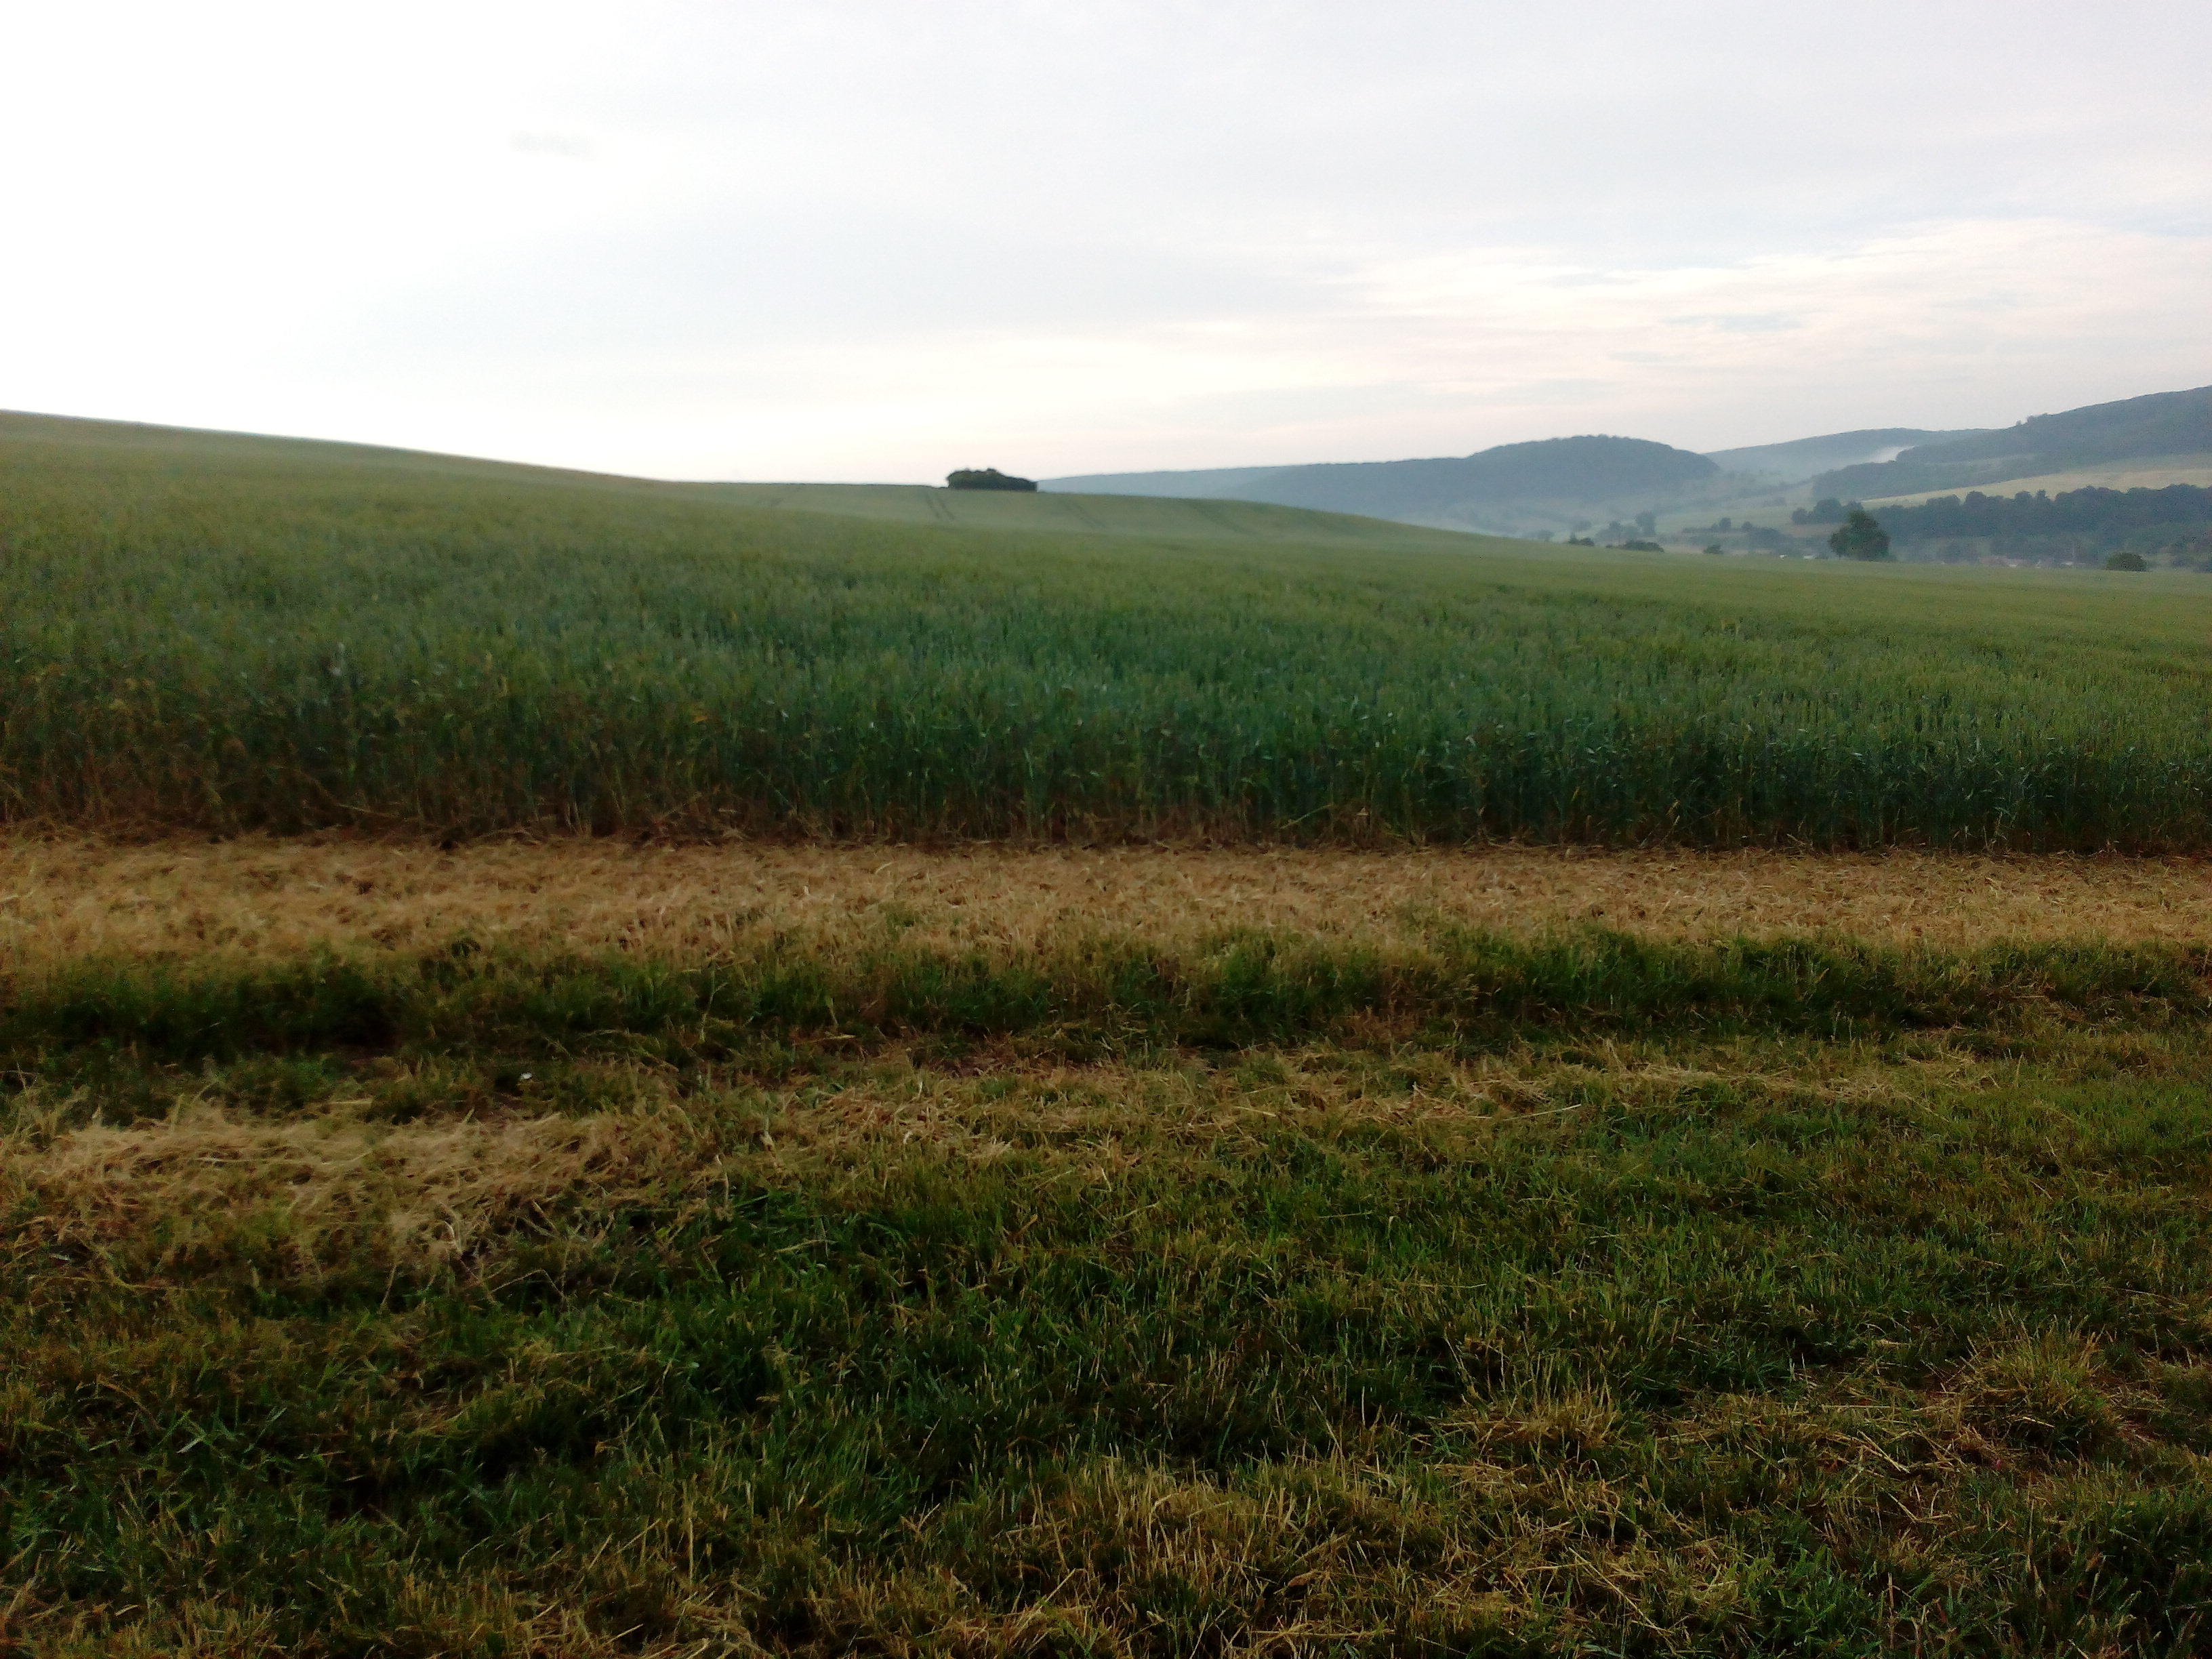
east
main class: Cropland
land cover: Common wheat
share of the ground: > 75 %
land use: Agriculture (excluding fallow land and kitchen gardens)
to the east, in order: Common wheat; Tracks; Common wheat
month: June
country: DE
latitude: 50.5615
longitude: 10.2681
